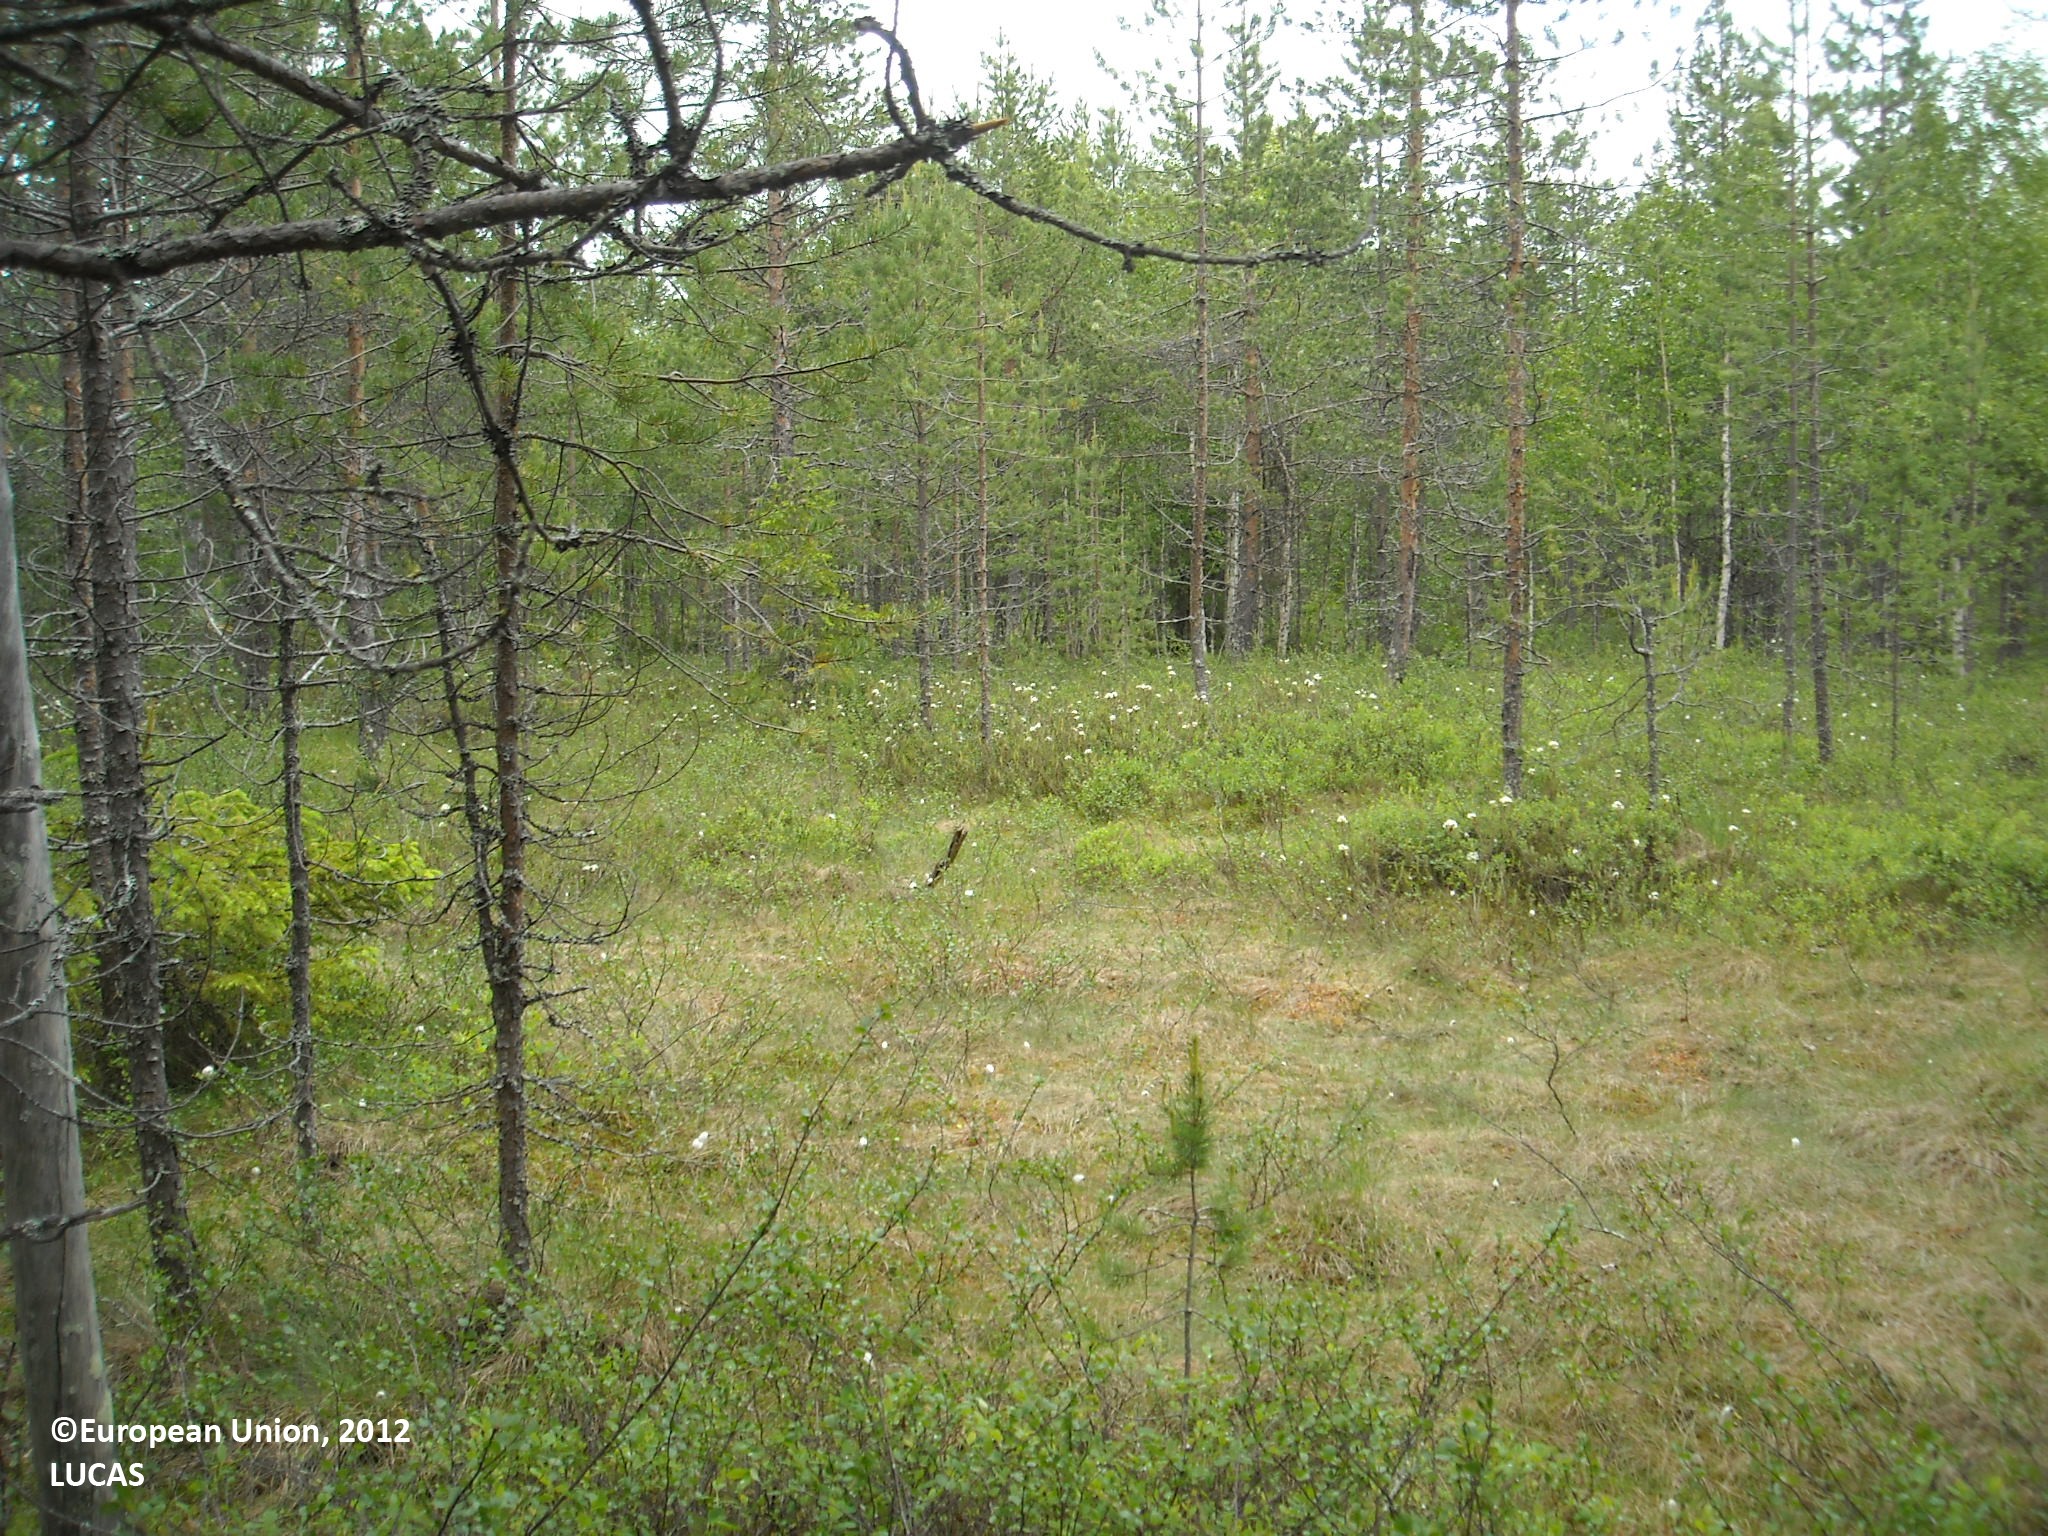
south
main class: Woodland
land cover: Pine dominated coniferous woodland
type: mire and swamp forests
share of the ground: 25 - 50 %
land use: Forestry
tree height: > 5 m
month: June
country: FI
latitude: 64.7650
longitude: 27.3957
